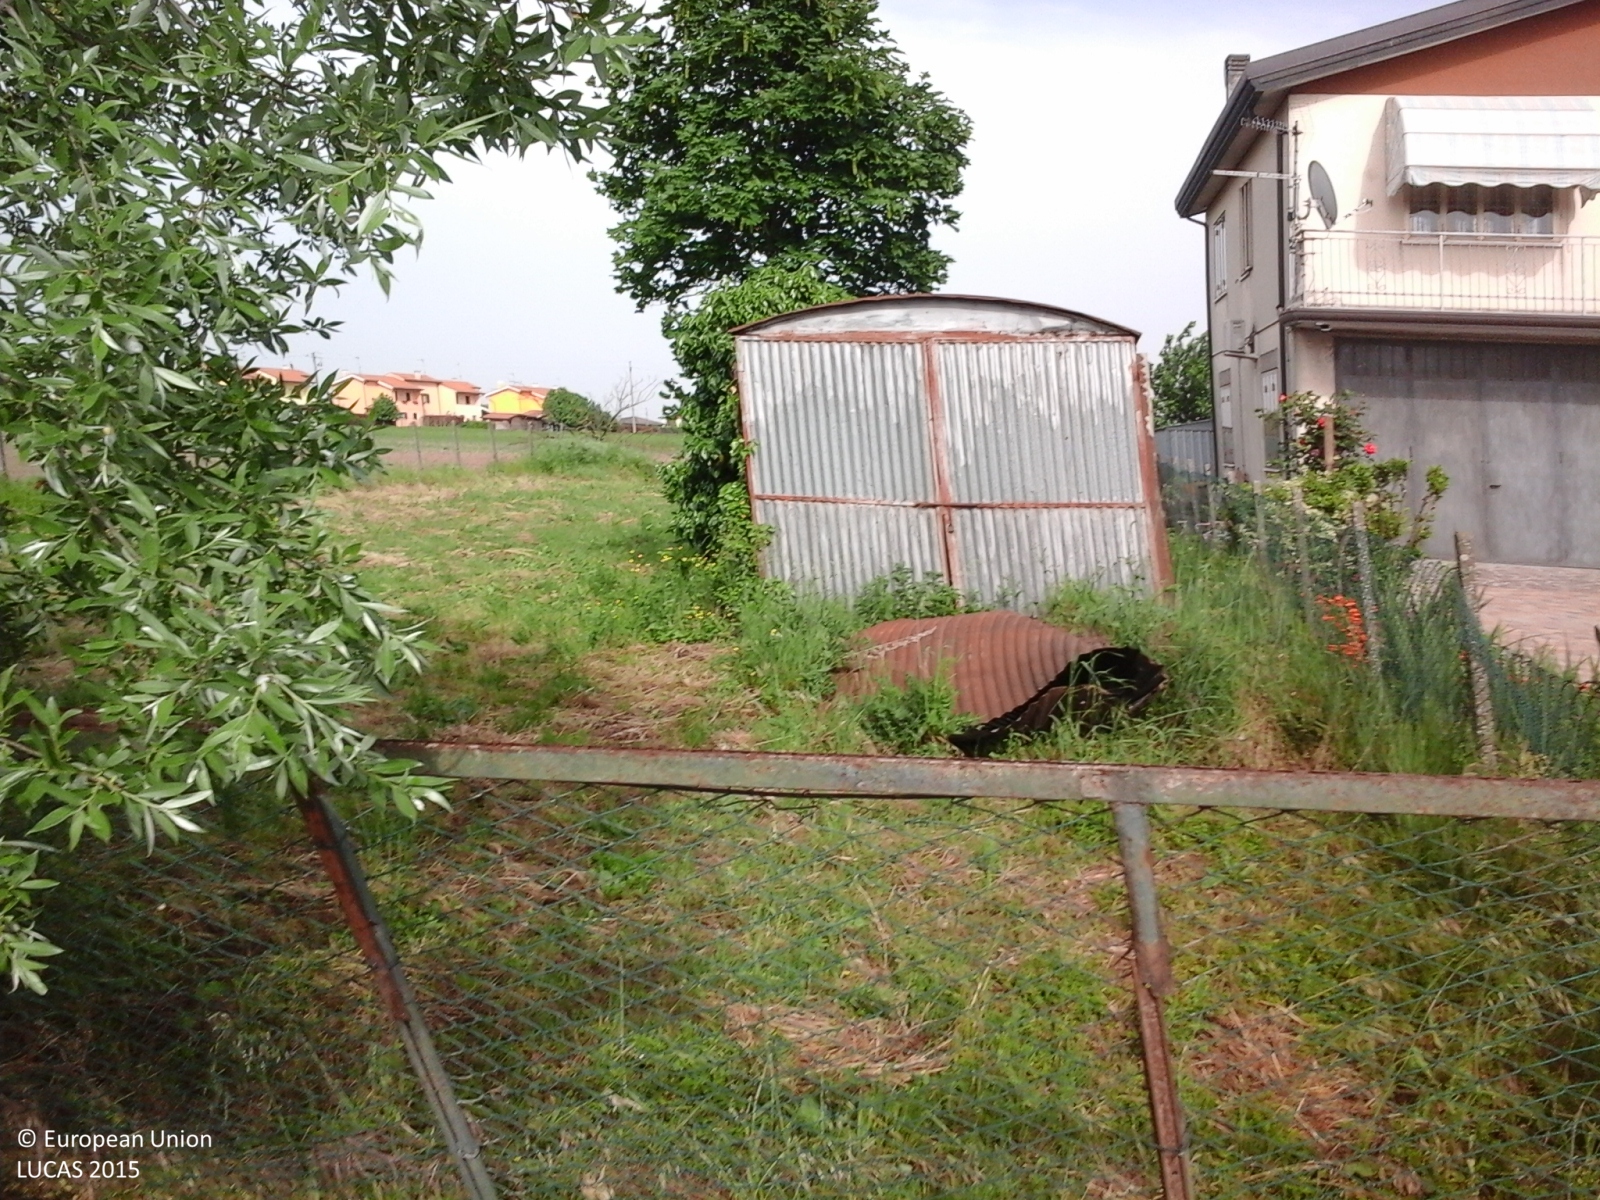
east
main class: Grassland
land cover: Grassland without tree/shrub cover
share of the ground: > 75 %
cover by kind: herbaceous plants 100 %
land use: Agriculture (excluding fallow land and kitchen gardens)
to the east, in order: Grassland without tree/shrub cover; Fences; Other bare soil; Ditches and canals; Other bare soil; Ditches and canals; Grassland without tree/shrub cover; Common wheat; Electric lines; Common wheat; Other bare soil
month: May
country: IT
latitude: 45.1480
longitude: 11.7139
